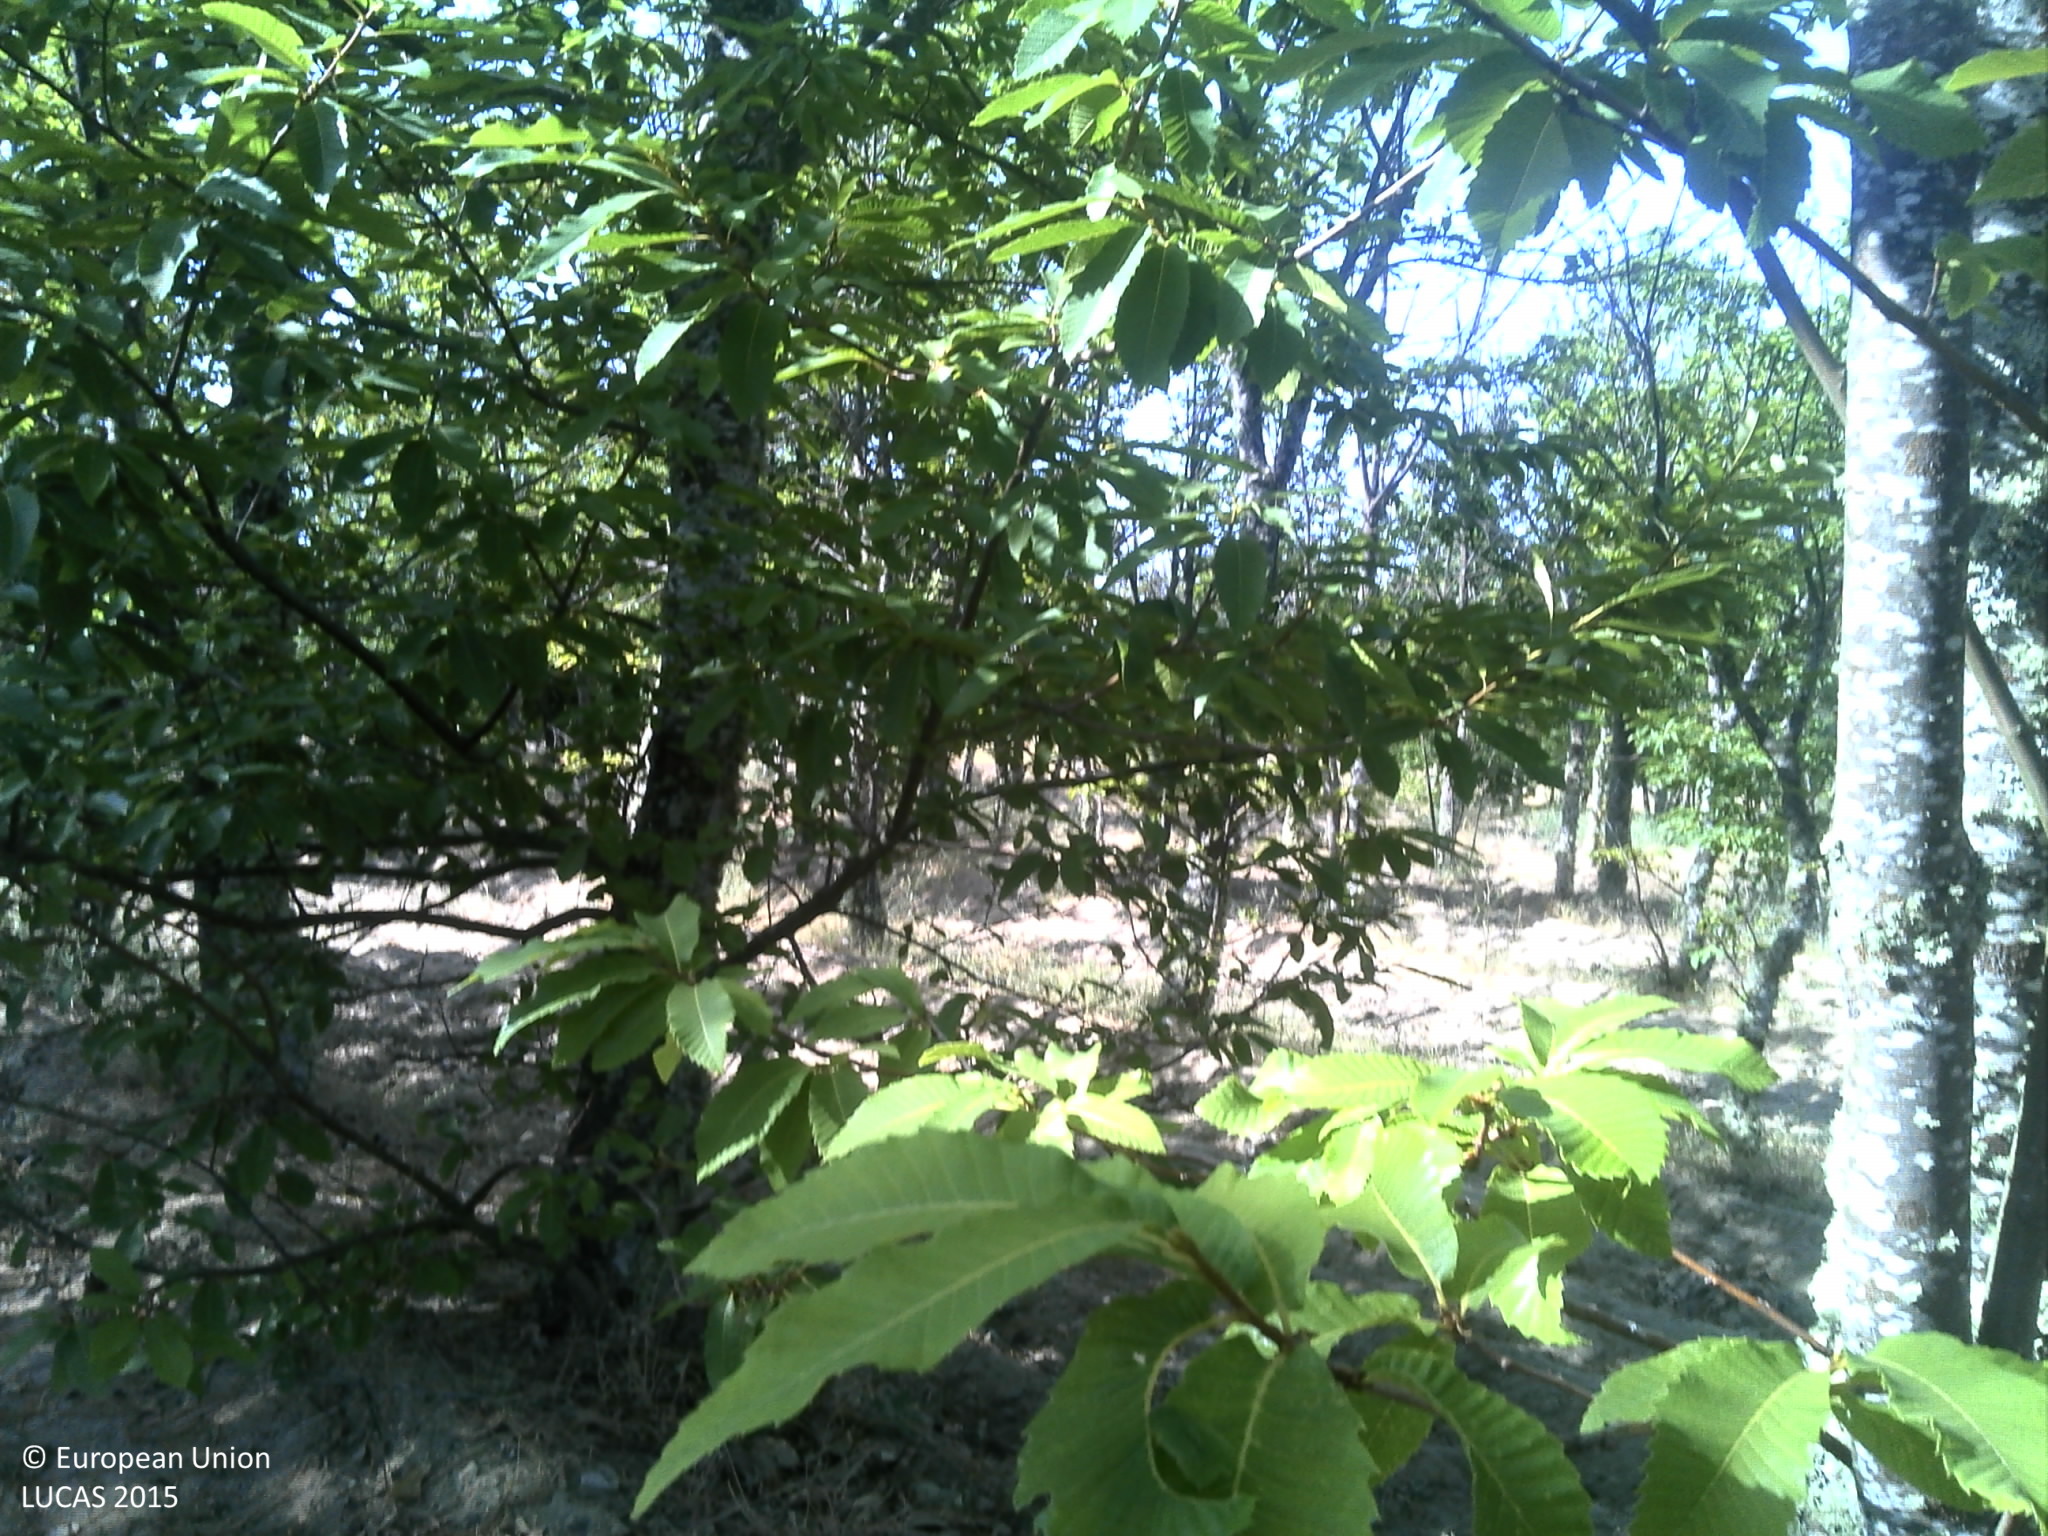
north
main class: Cropland
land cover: Nuts trees
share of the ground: 50 - 75 %
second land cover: Other bare soil
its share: > 75 %
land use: Agriculture (excluding fallow land and kitchen gardens)
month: July
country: PT
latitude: 40.8527
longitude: -7.3244
